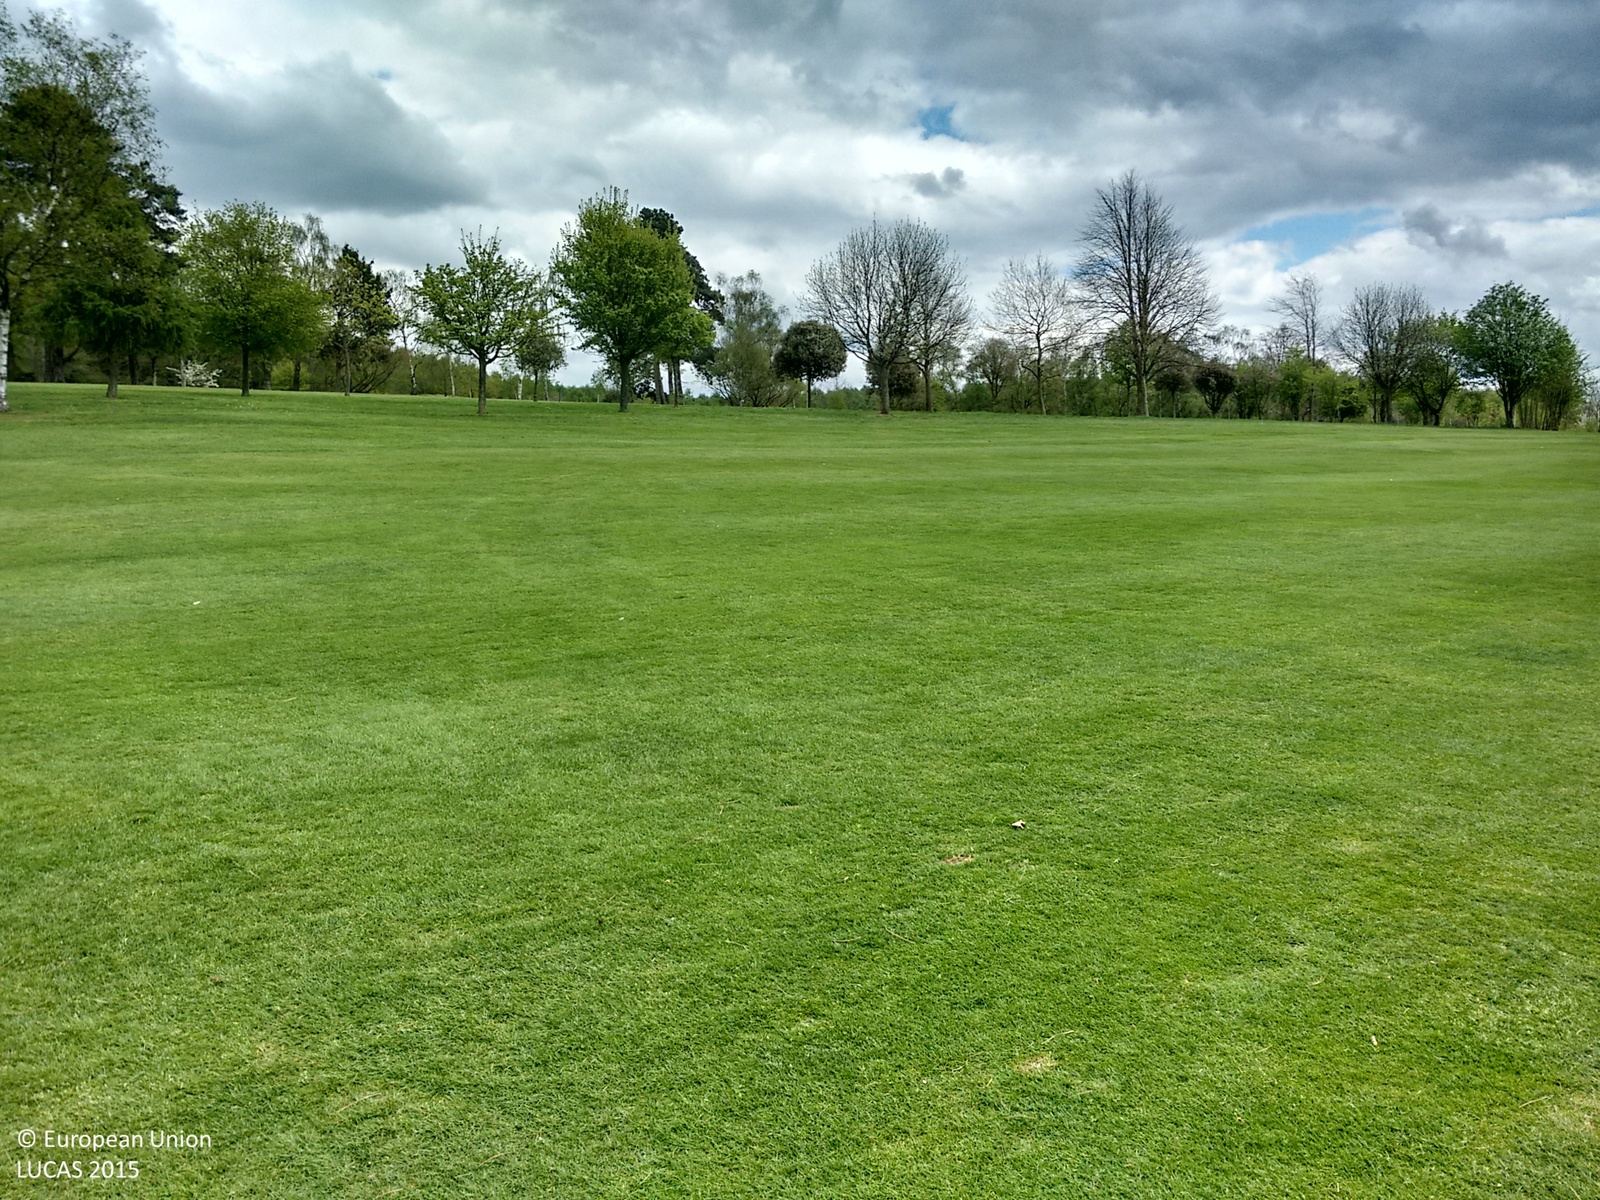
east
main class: Grassland
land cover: Grassland without tree/shrub cover
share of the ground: > 75 %
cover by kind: herbaceous plants 100 %
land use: Sport
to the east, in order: Grassland without tree/shrub cover; Grassland with sparse tree/shrub cover; Grassland without tree/shrub cover; Broadleaved woodland; Grassland without tree/shrub cover; Grassland with sparse tree/shrub cover; Grassland without tree/shrub cover; Broadleaved woodland
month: April
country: GB
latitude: 51.6498
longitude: -0.5755
